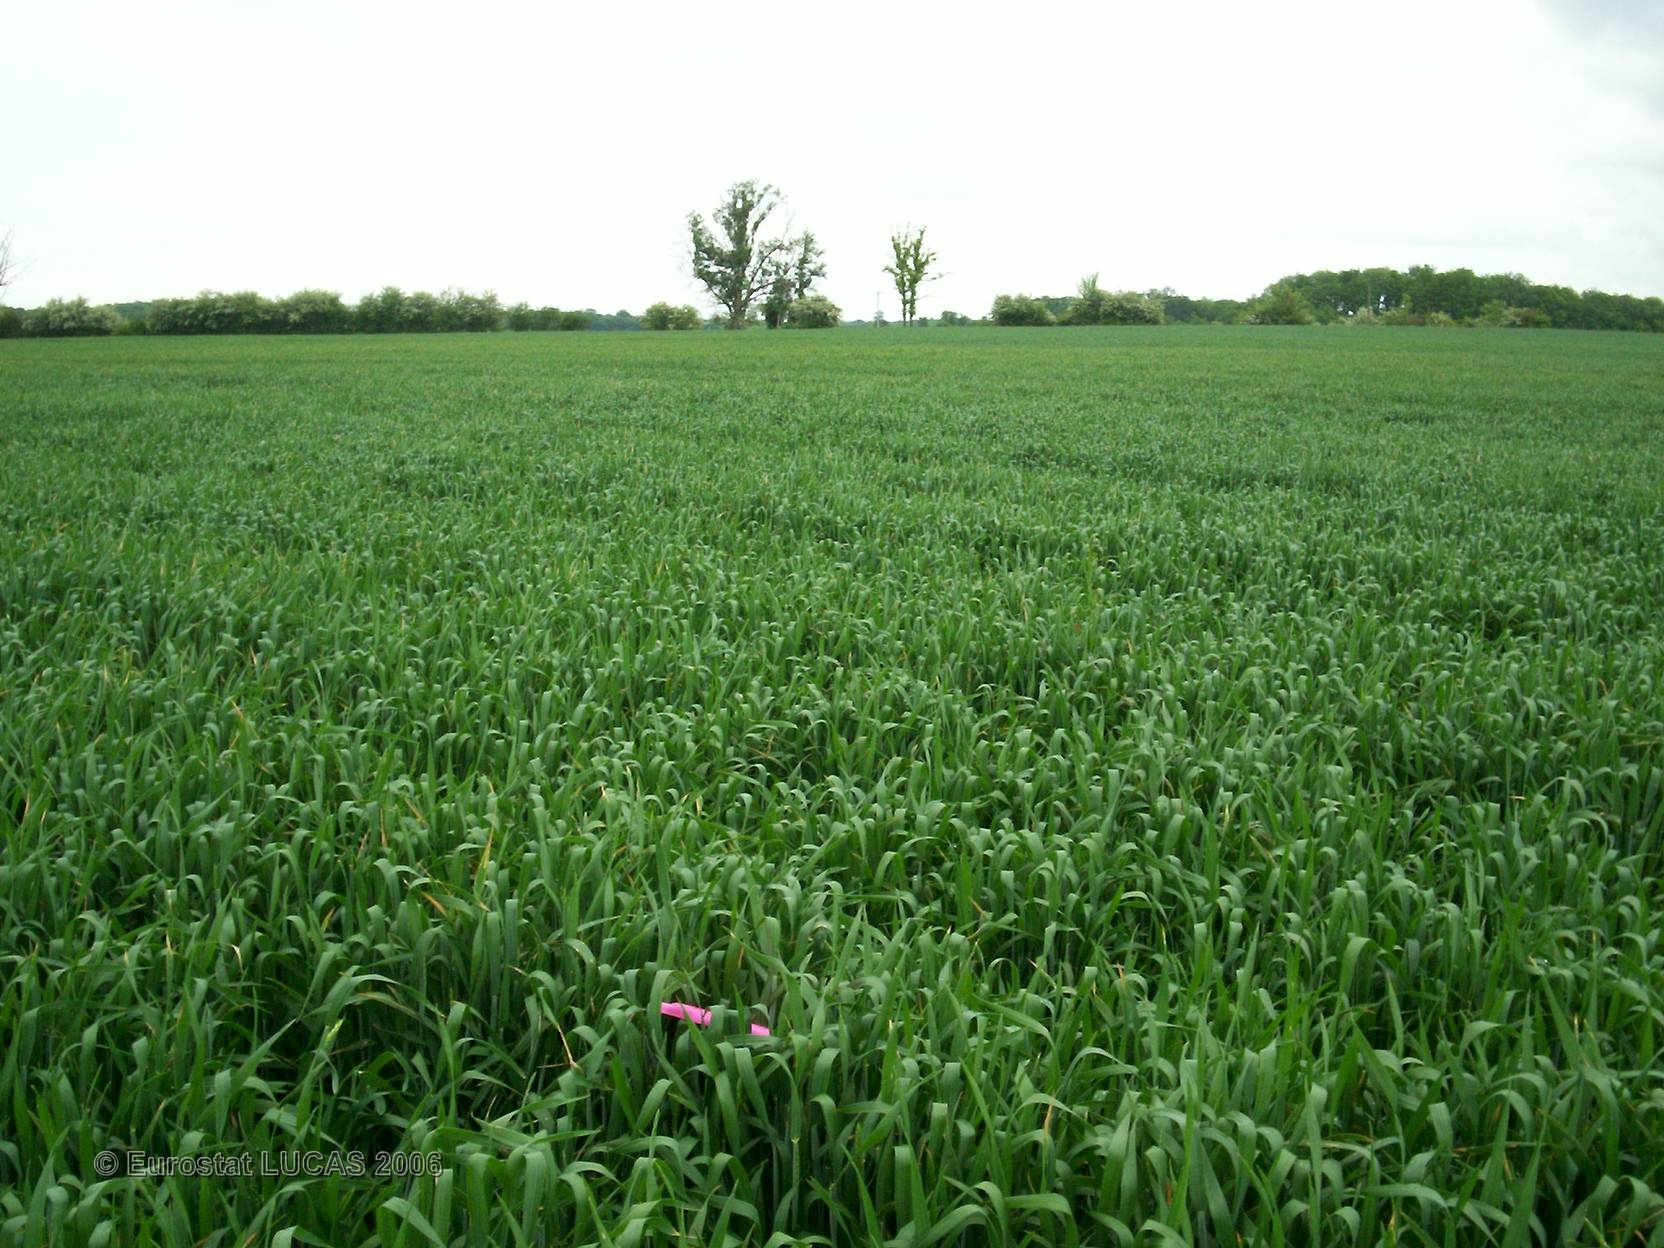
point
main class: Cropland
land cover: Common wheat
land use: Agriculture (excluding fallow land and kitchen gardens)
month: May
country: FR
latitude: 48.2467
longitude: 4.4627
